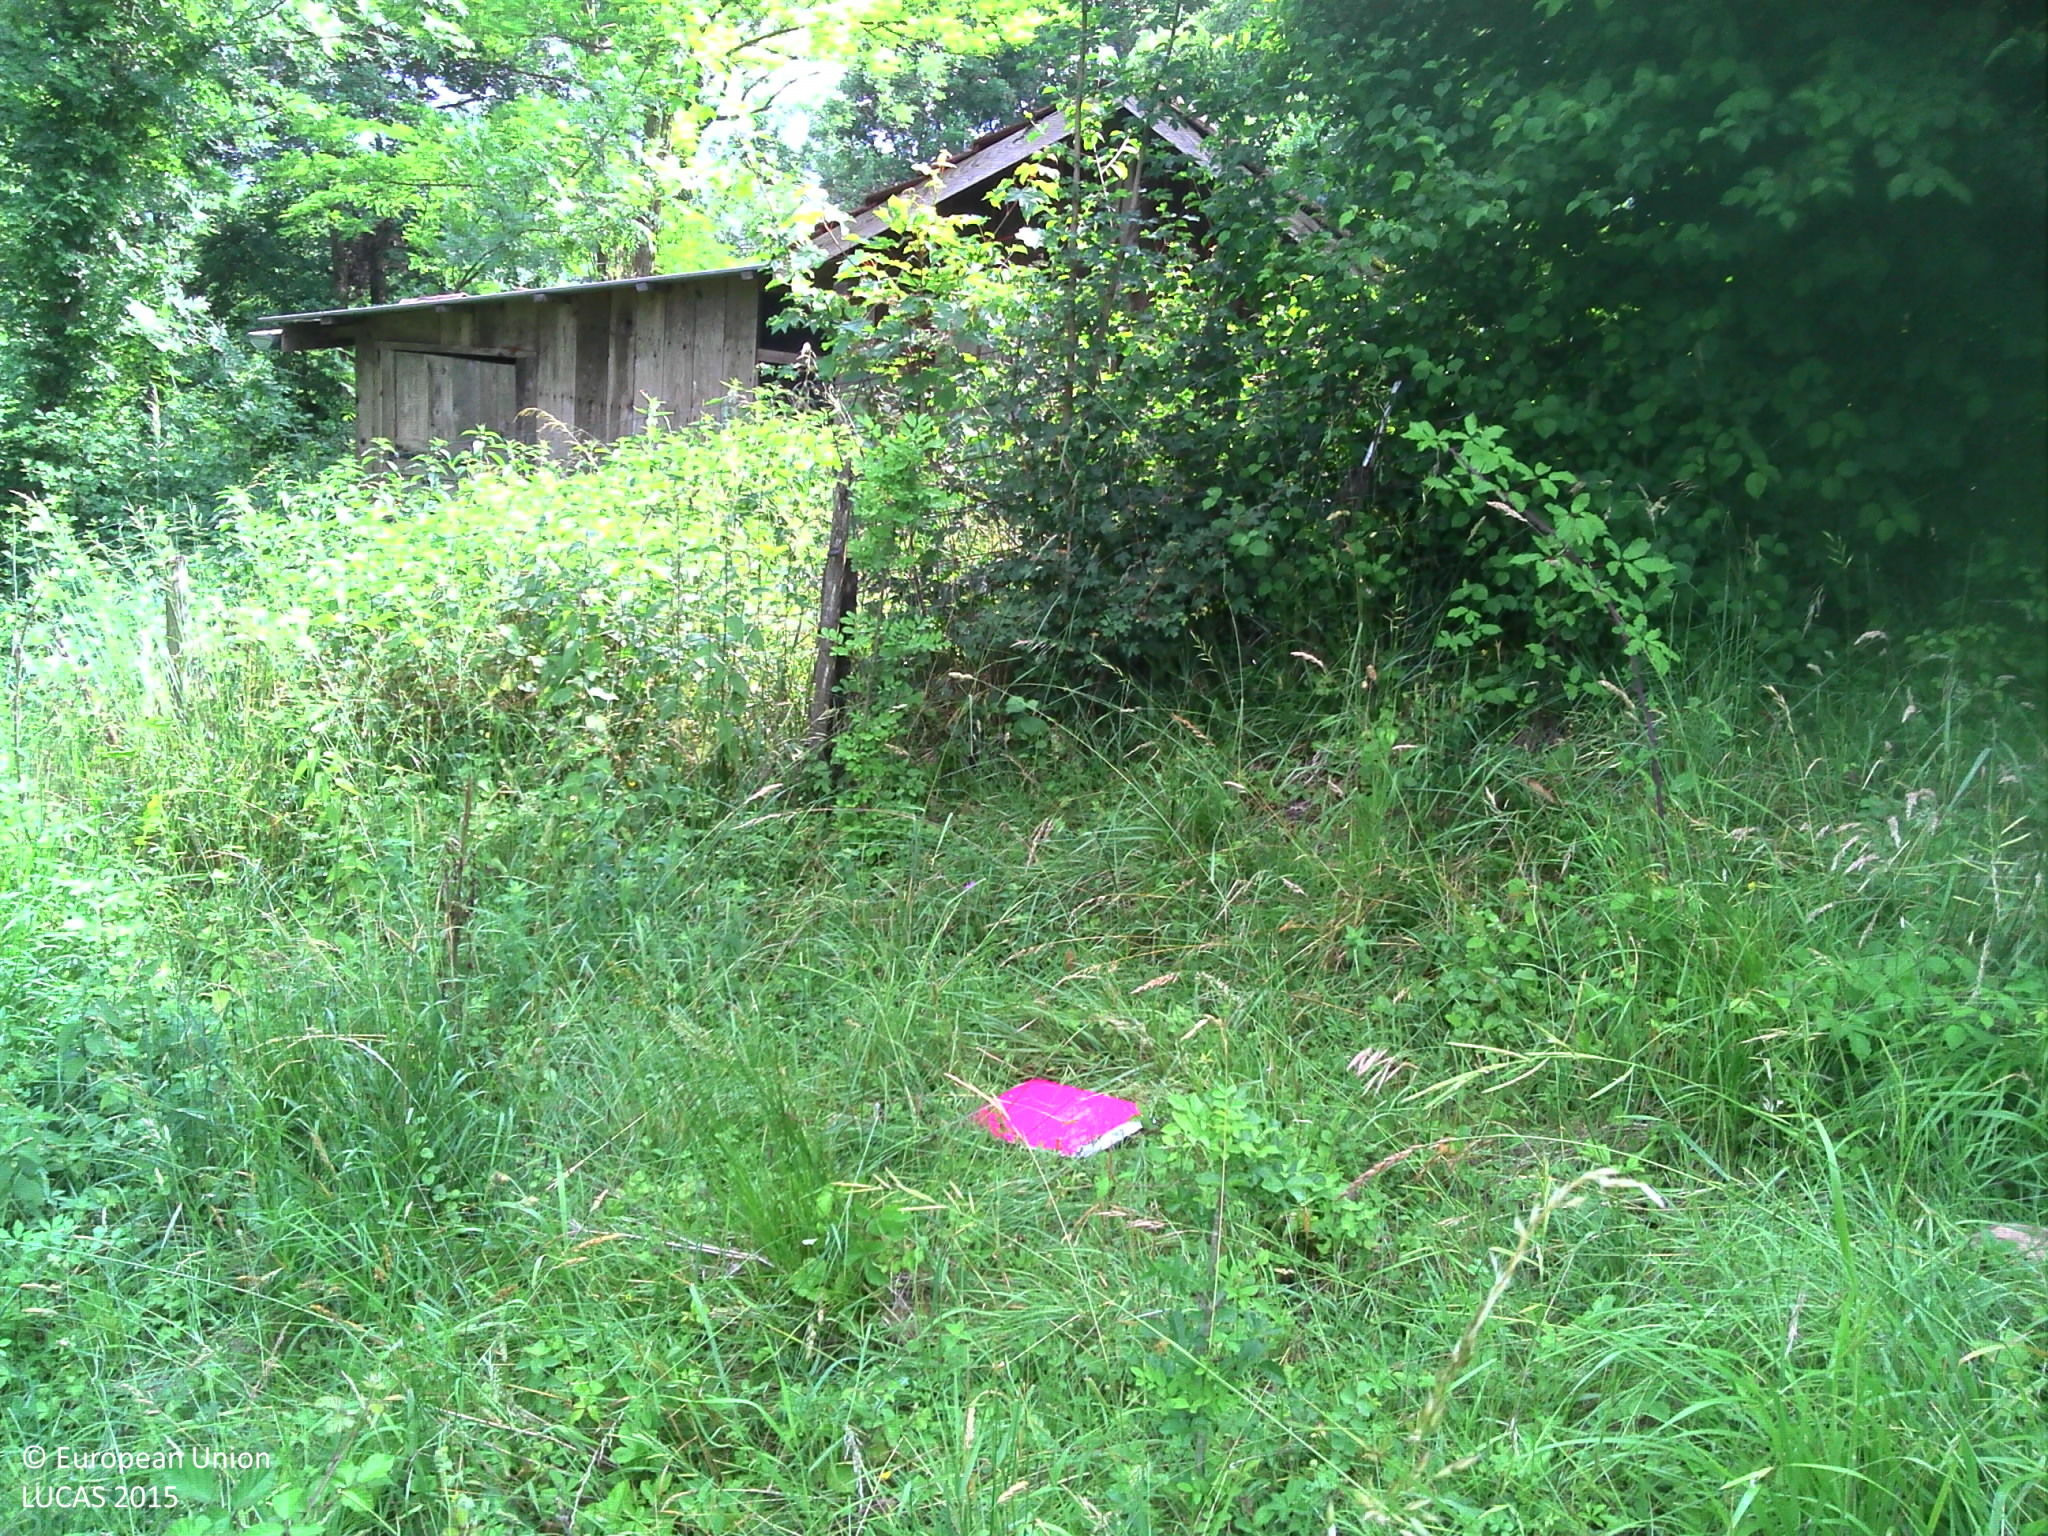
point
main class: Grassland
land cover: Spontaneously vegetated surfaces
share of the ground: > 75 %
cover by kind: herbaceous plants 95 %, shrubs 5 %
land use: Abandoned areas
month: June
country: FR
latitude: 45.5065
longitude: 6.1521
